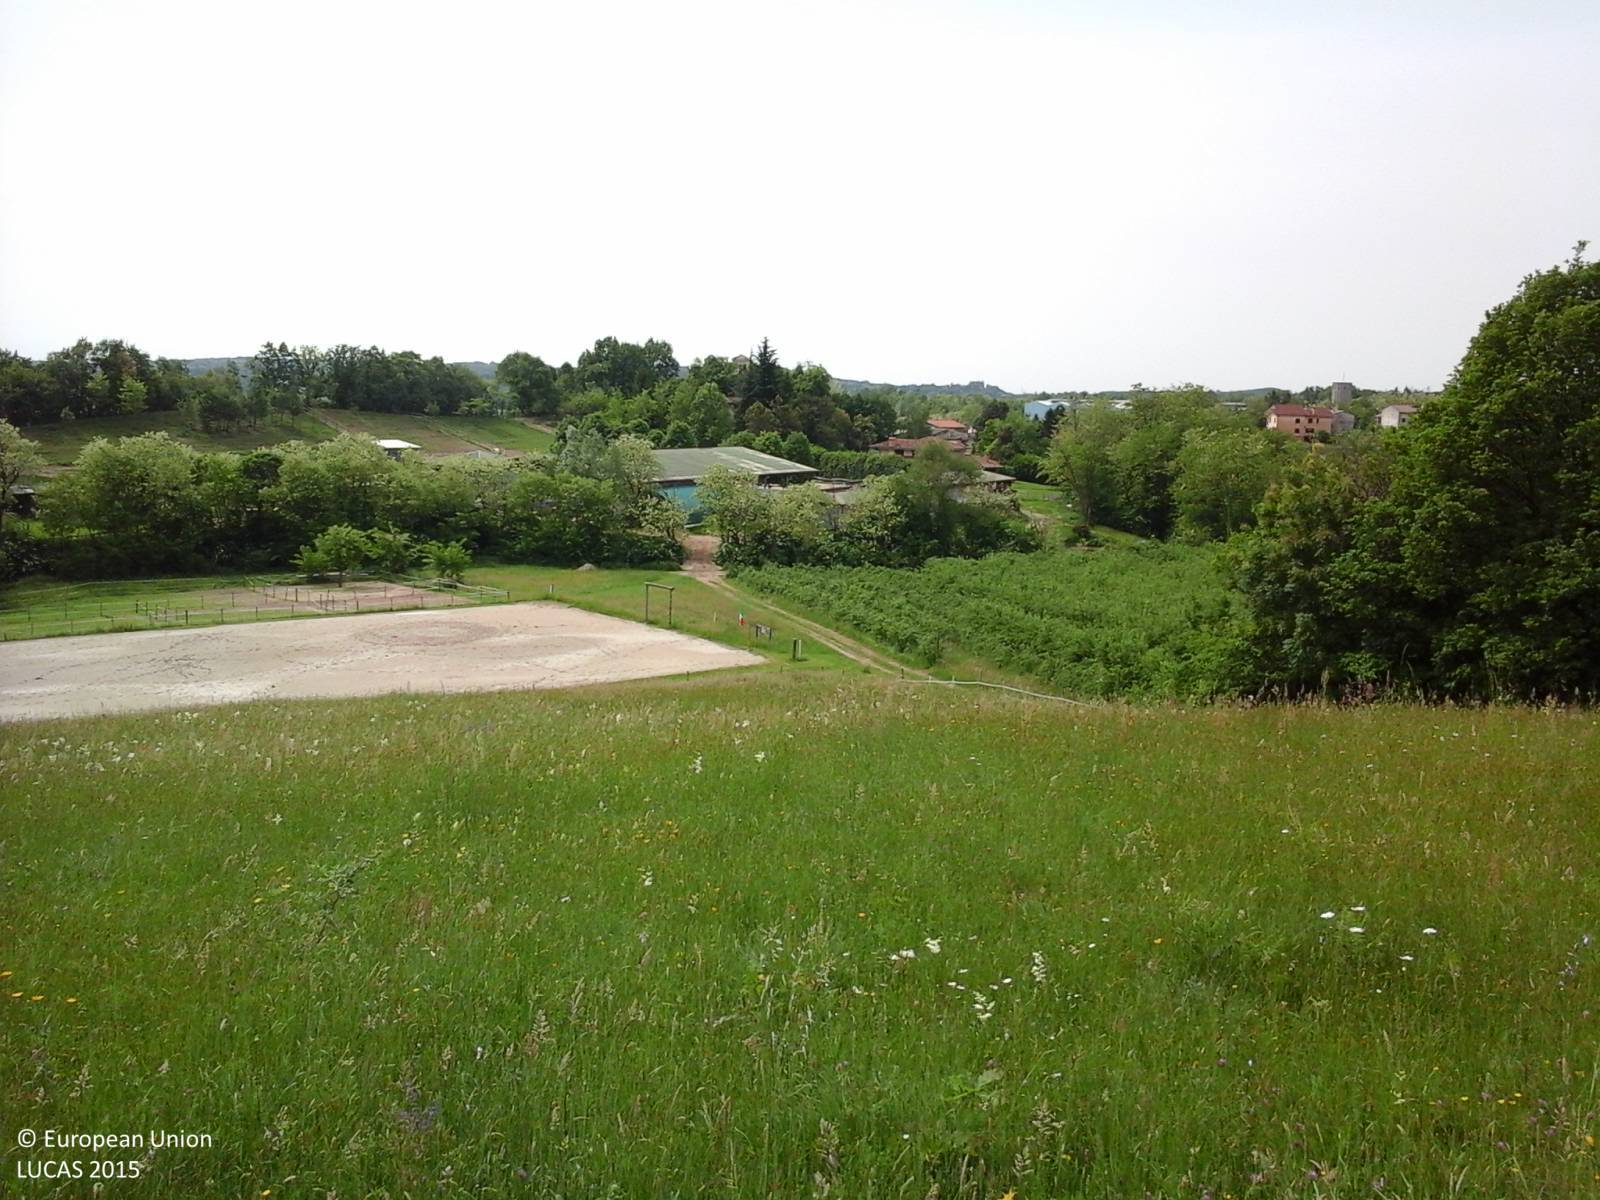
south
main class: Grassland
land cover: Grassland without tree/shrub cover
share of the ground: > 75 %
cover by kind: herbaceous plants 100 %
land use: Agriculture (excluding fallow land and kitchen gardens)
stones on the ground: < 10 %
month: May
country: IT
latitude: 46.1818
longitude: 13.0411
